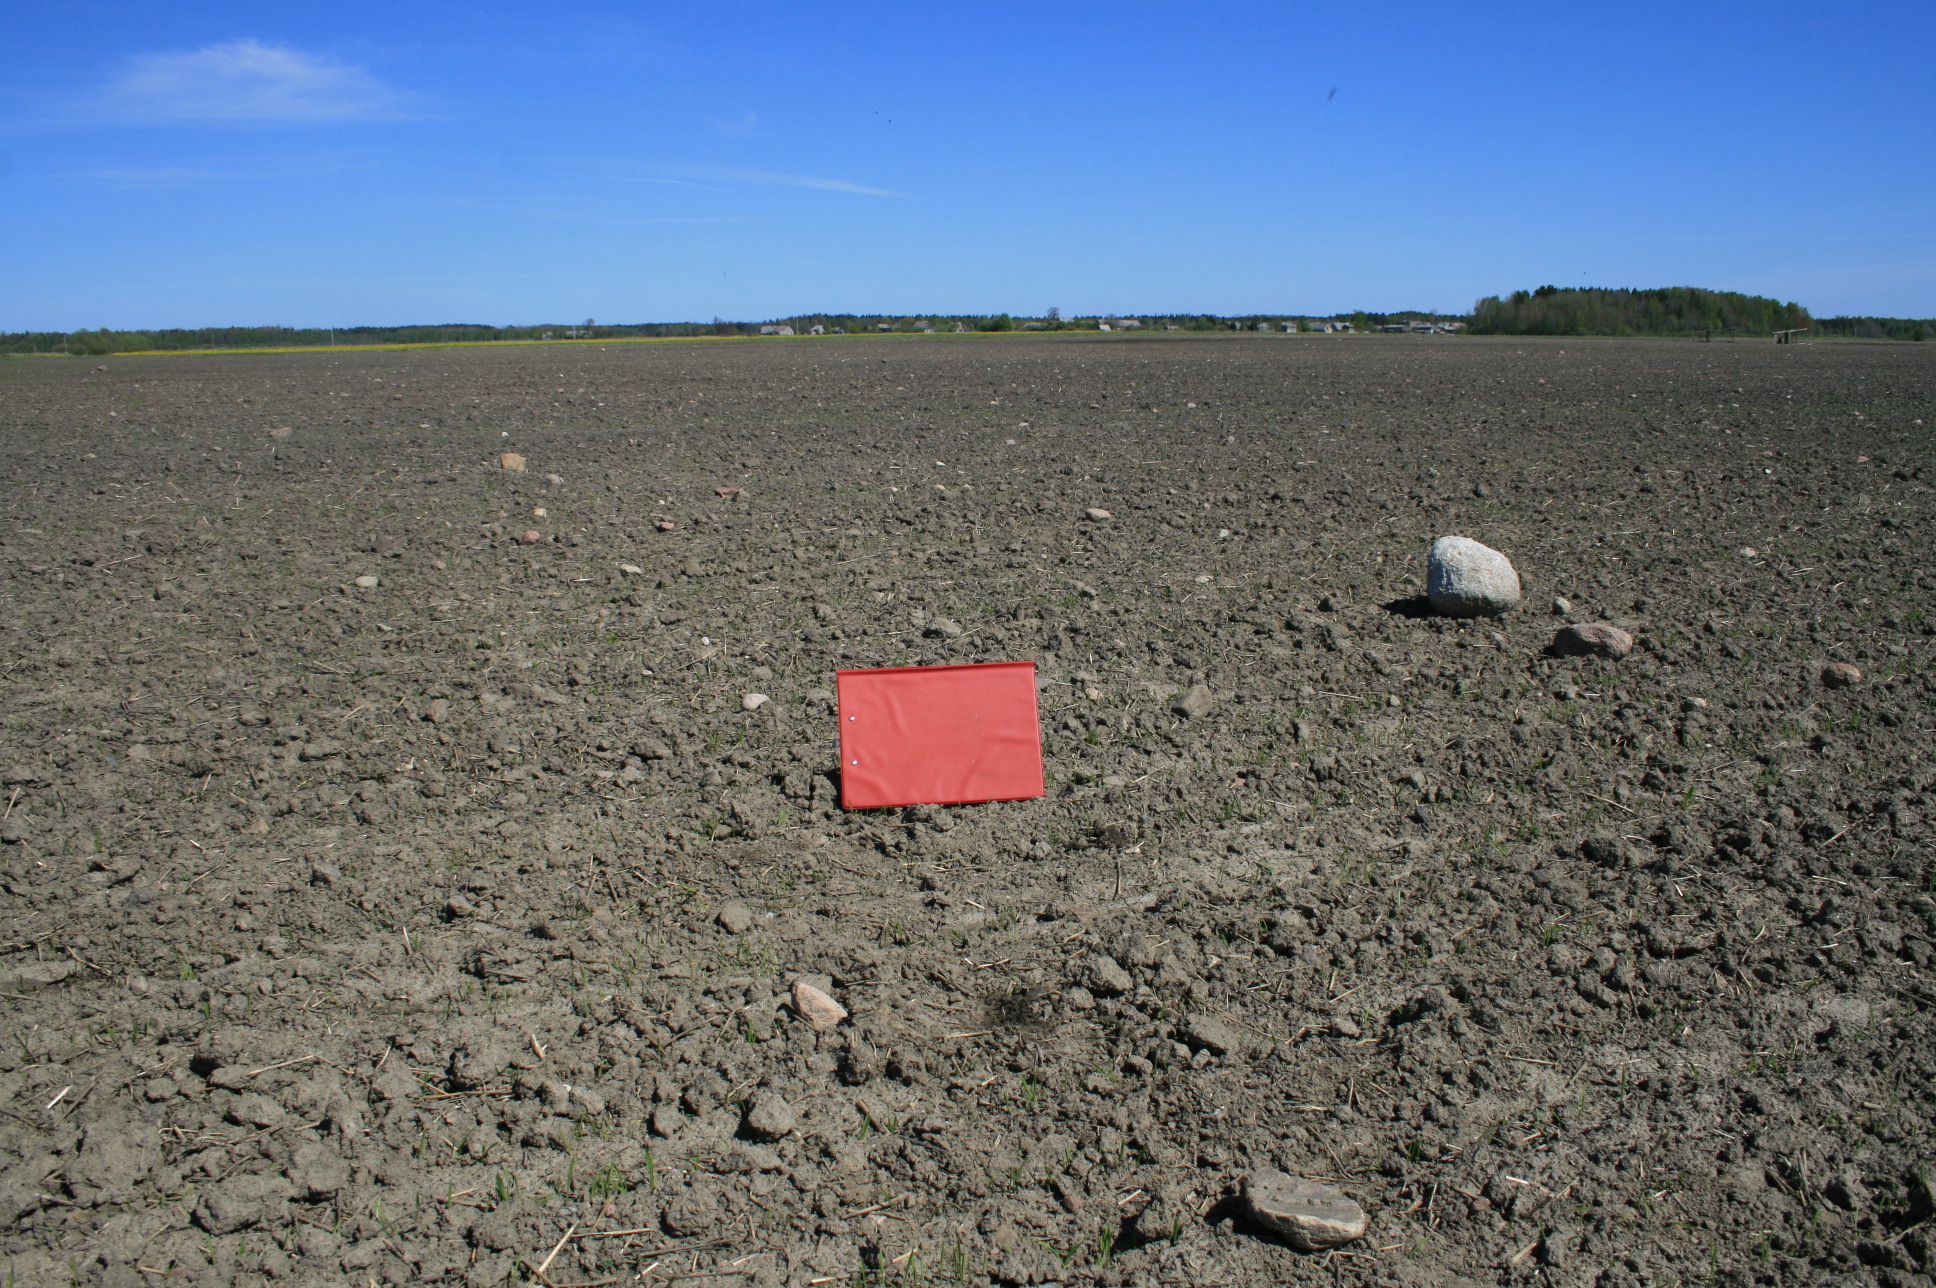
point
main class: Cropland
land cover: Common wheat
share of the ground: 10 - 25 %
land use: Agriculture (excluding fallow land and kitchen gardens)
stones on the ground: < 10 %
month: May
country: LT
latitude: 56.1010
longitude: 21.3436
